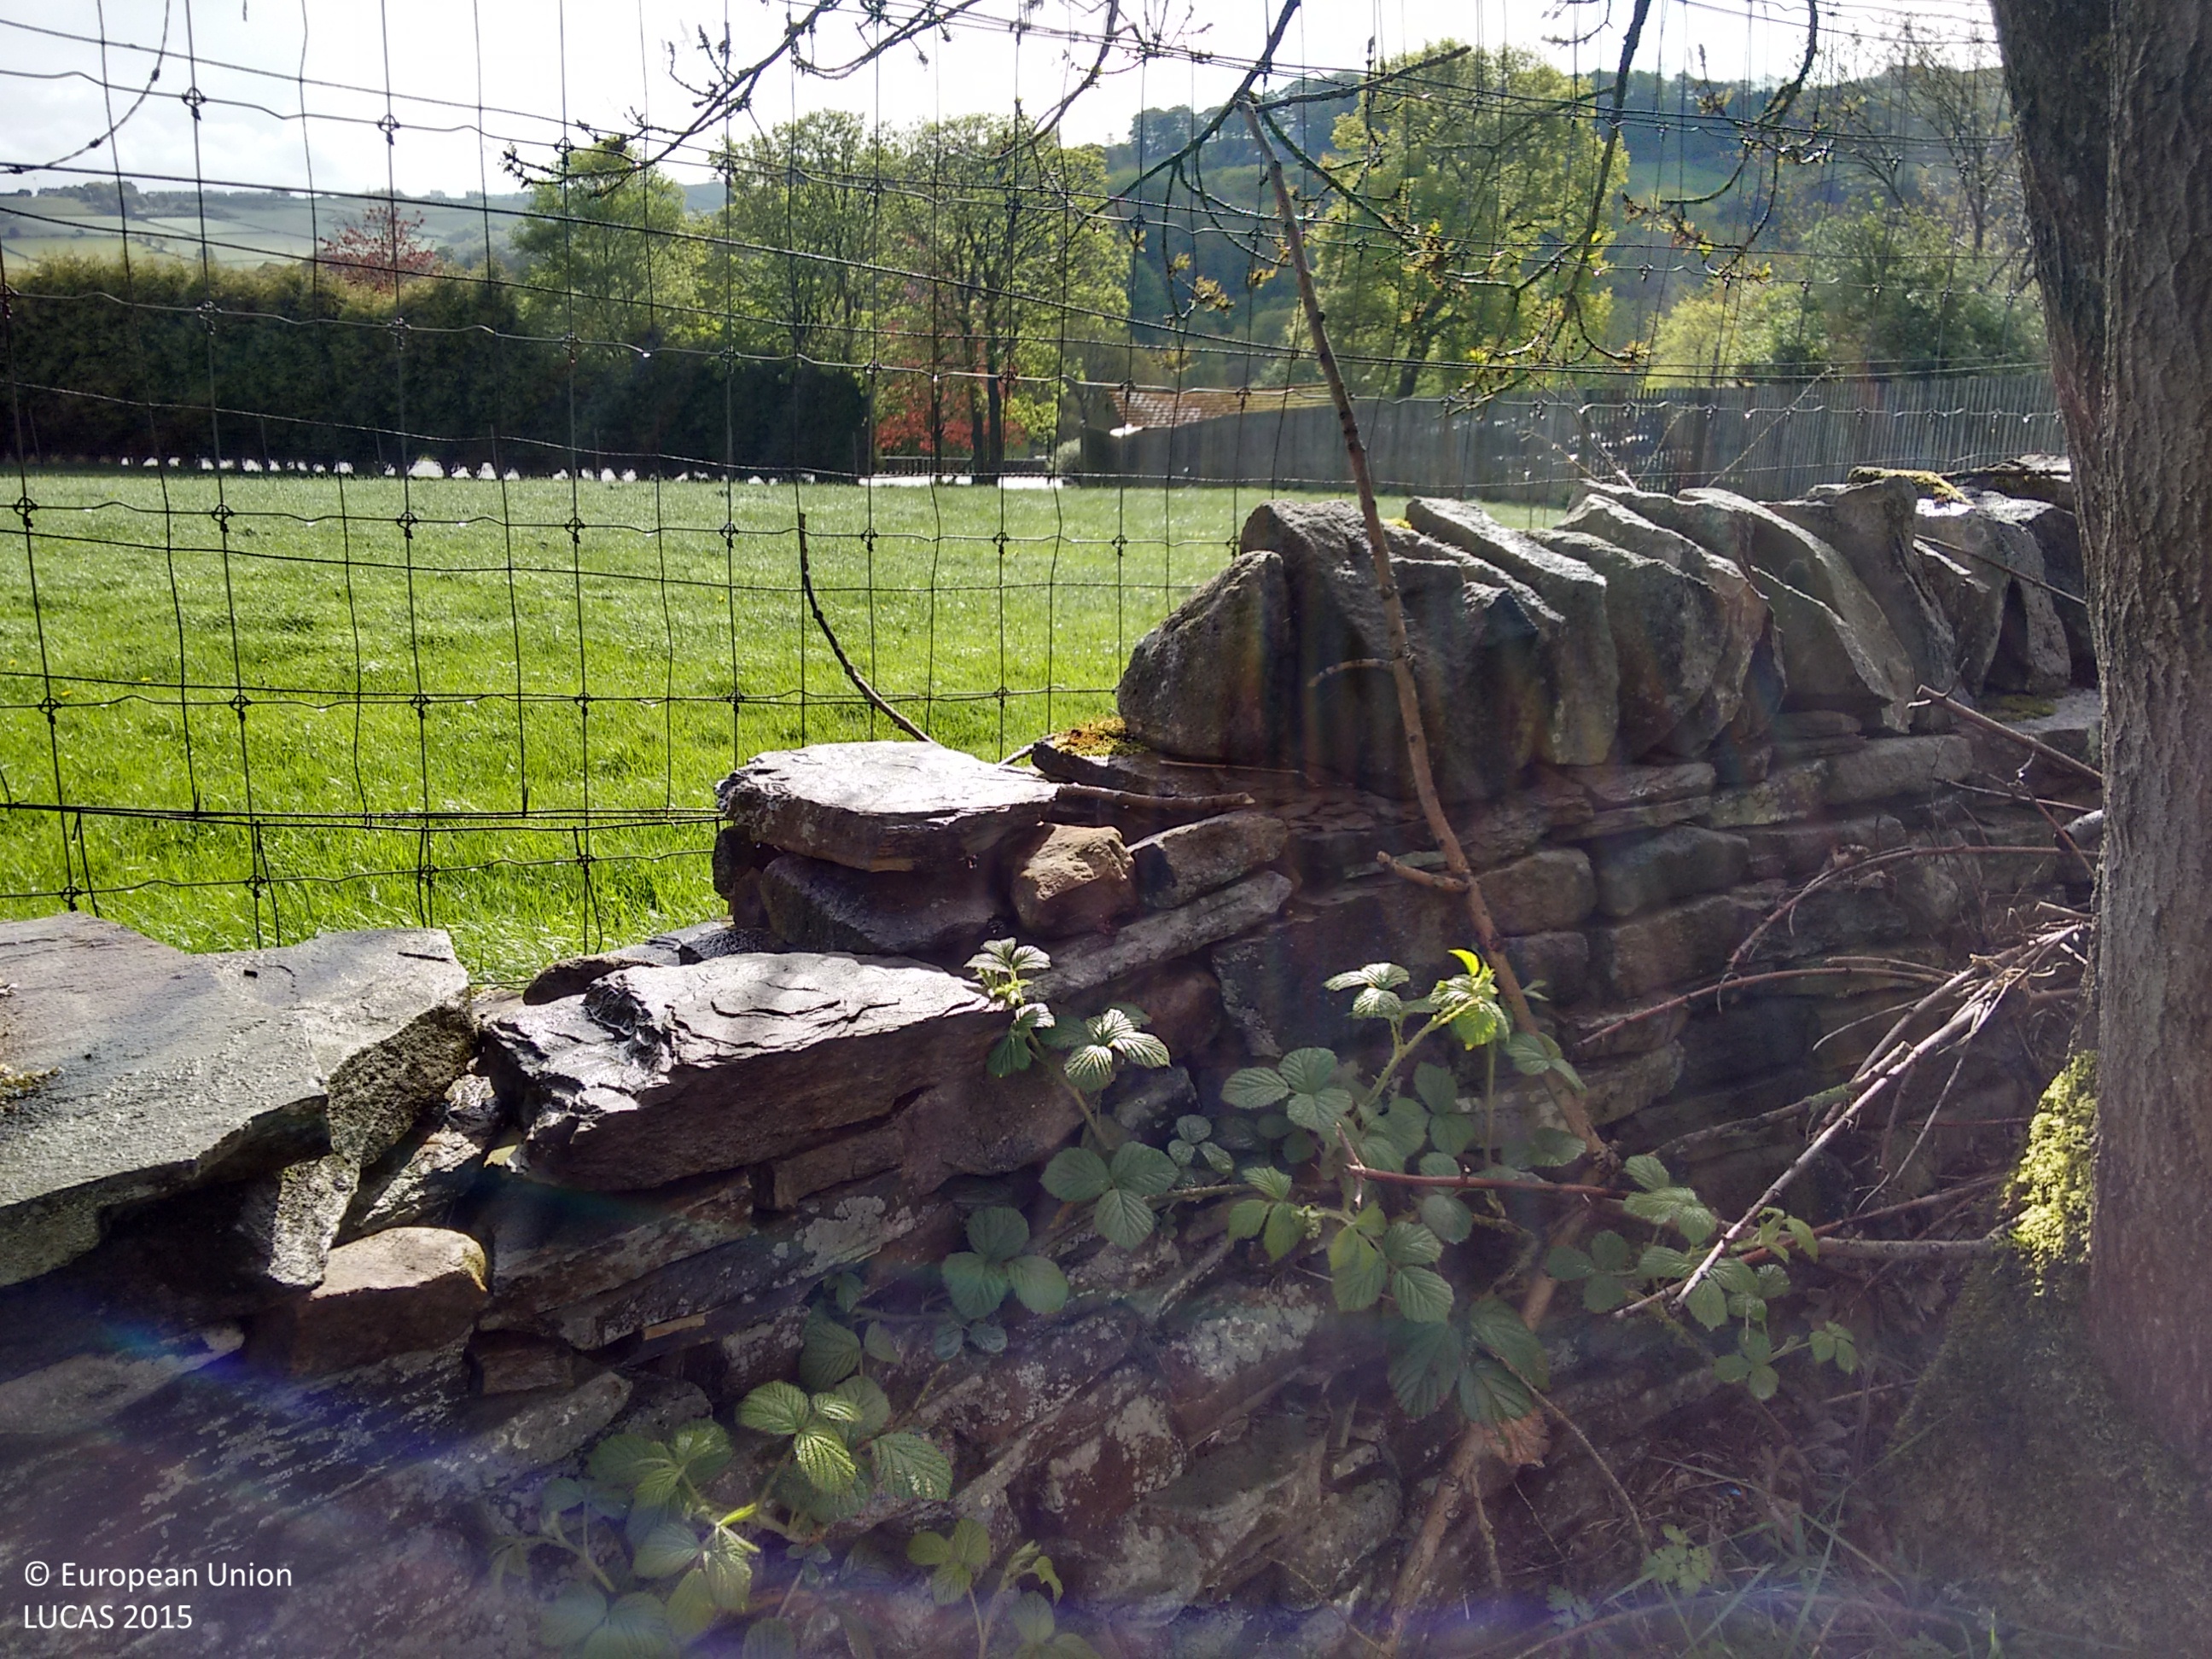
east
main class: Grassland
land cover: Grassland without tree/shrub cover
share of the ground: > 75 %
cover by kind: herbaceous plants 100 %
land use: Agriculture (excluding fallow land and kitchen gardens)
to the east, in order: Grassland without tree/shrub cover; Dry stone walls; Grassland with sparse tree/shrub cover; Dry stone walls; Grass margins; Abandoned hedges; Tracks; Grass margins; Abandoned hedges; Dry stone walls; Fences; Grassland without tree/shrub cover; Fences; Managed hedges; Grass margins; Tracks; Grassland without tree/shrub cover
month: May
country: GB
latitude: 53.6696
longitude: -1.8765
